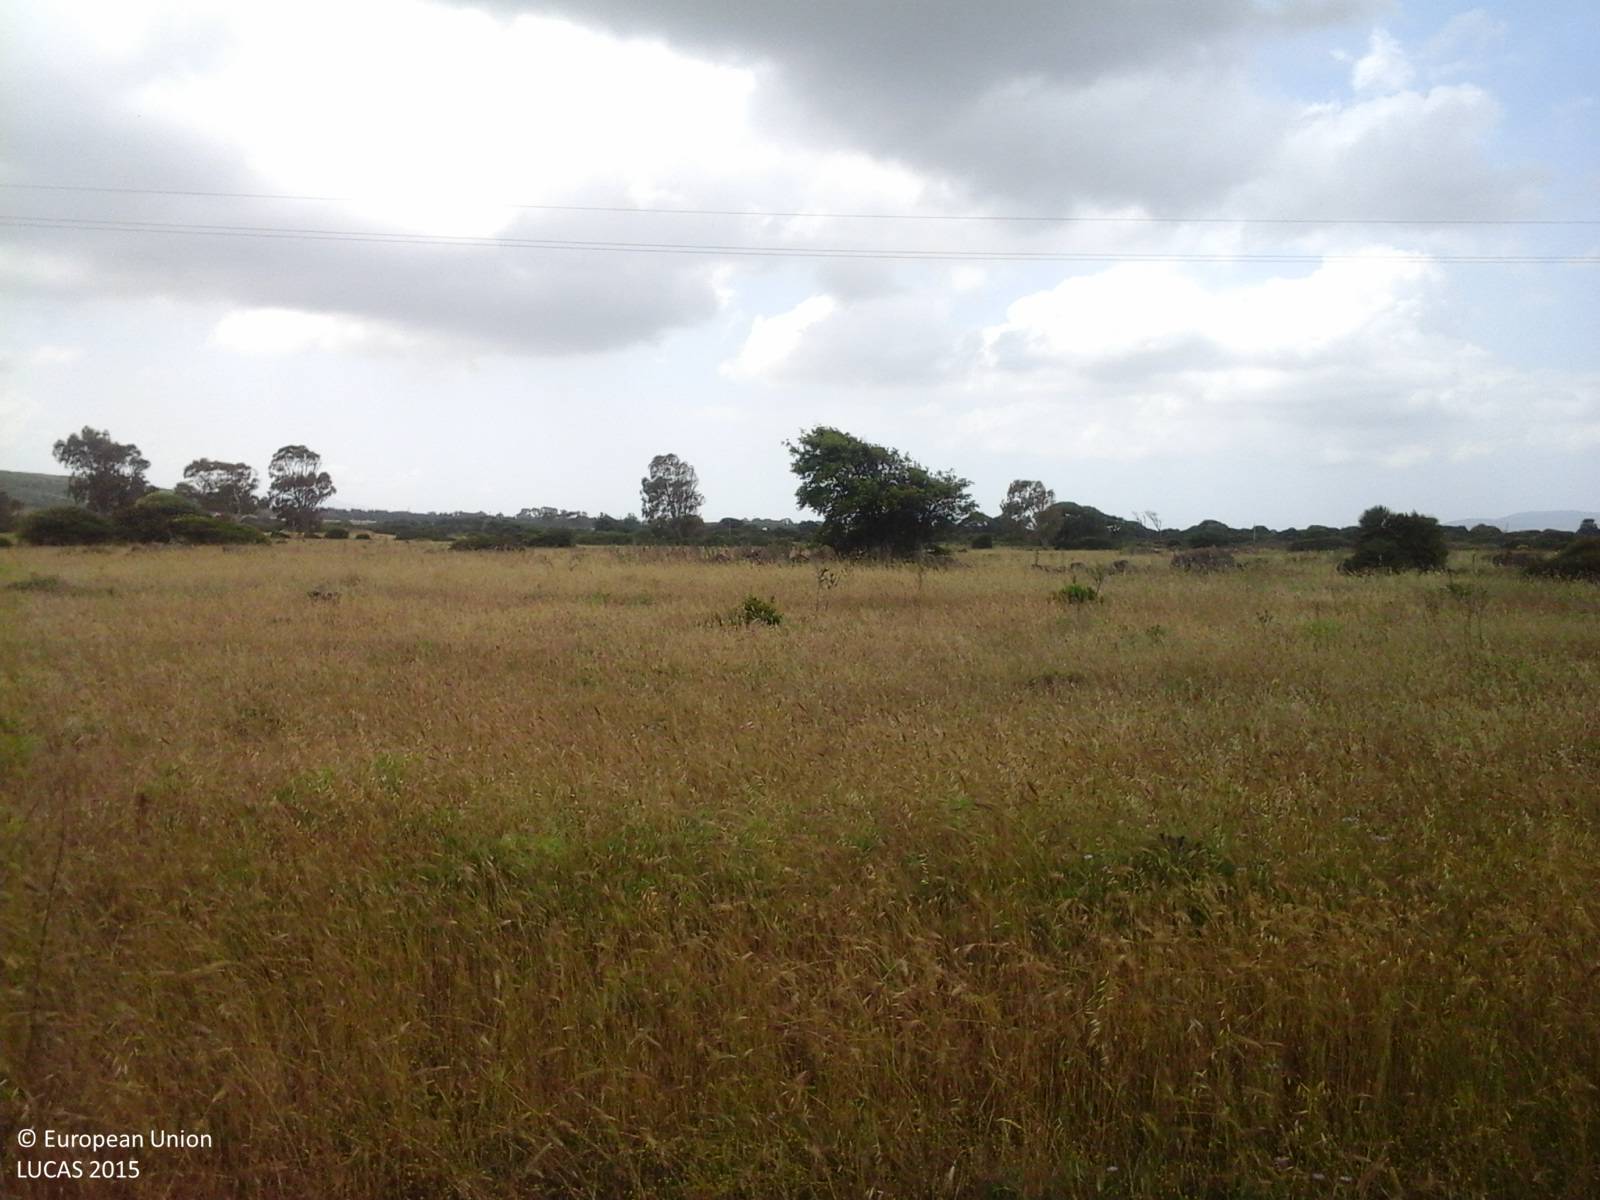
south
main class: Grassland
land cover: Grassland without tree/shrub cover
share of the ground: > 75 %
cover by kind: herbaceous plants 100 %
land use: Agriculture (excluding fallow land and kitchen gardens)
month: May
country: IT
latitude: 40.7058
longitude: 8.3391
